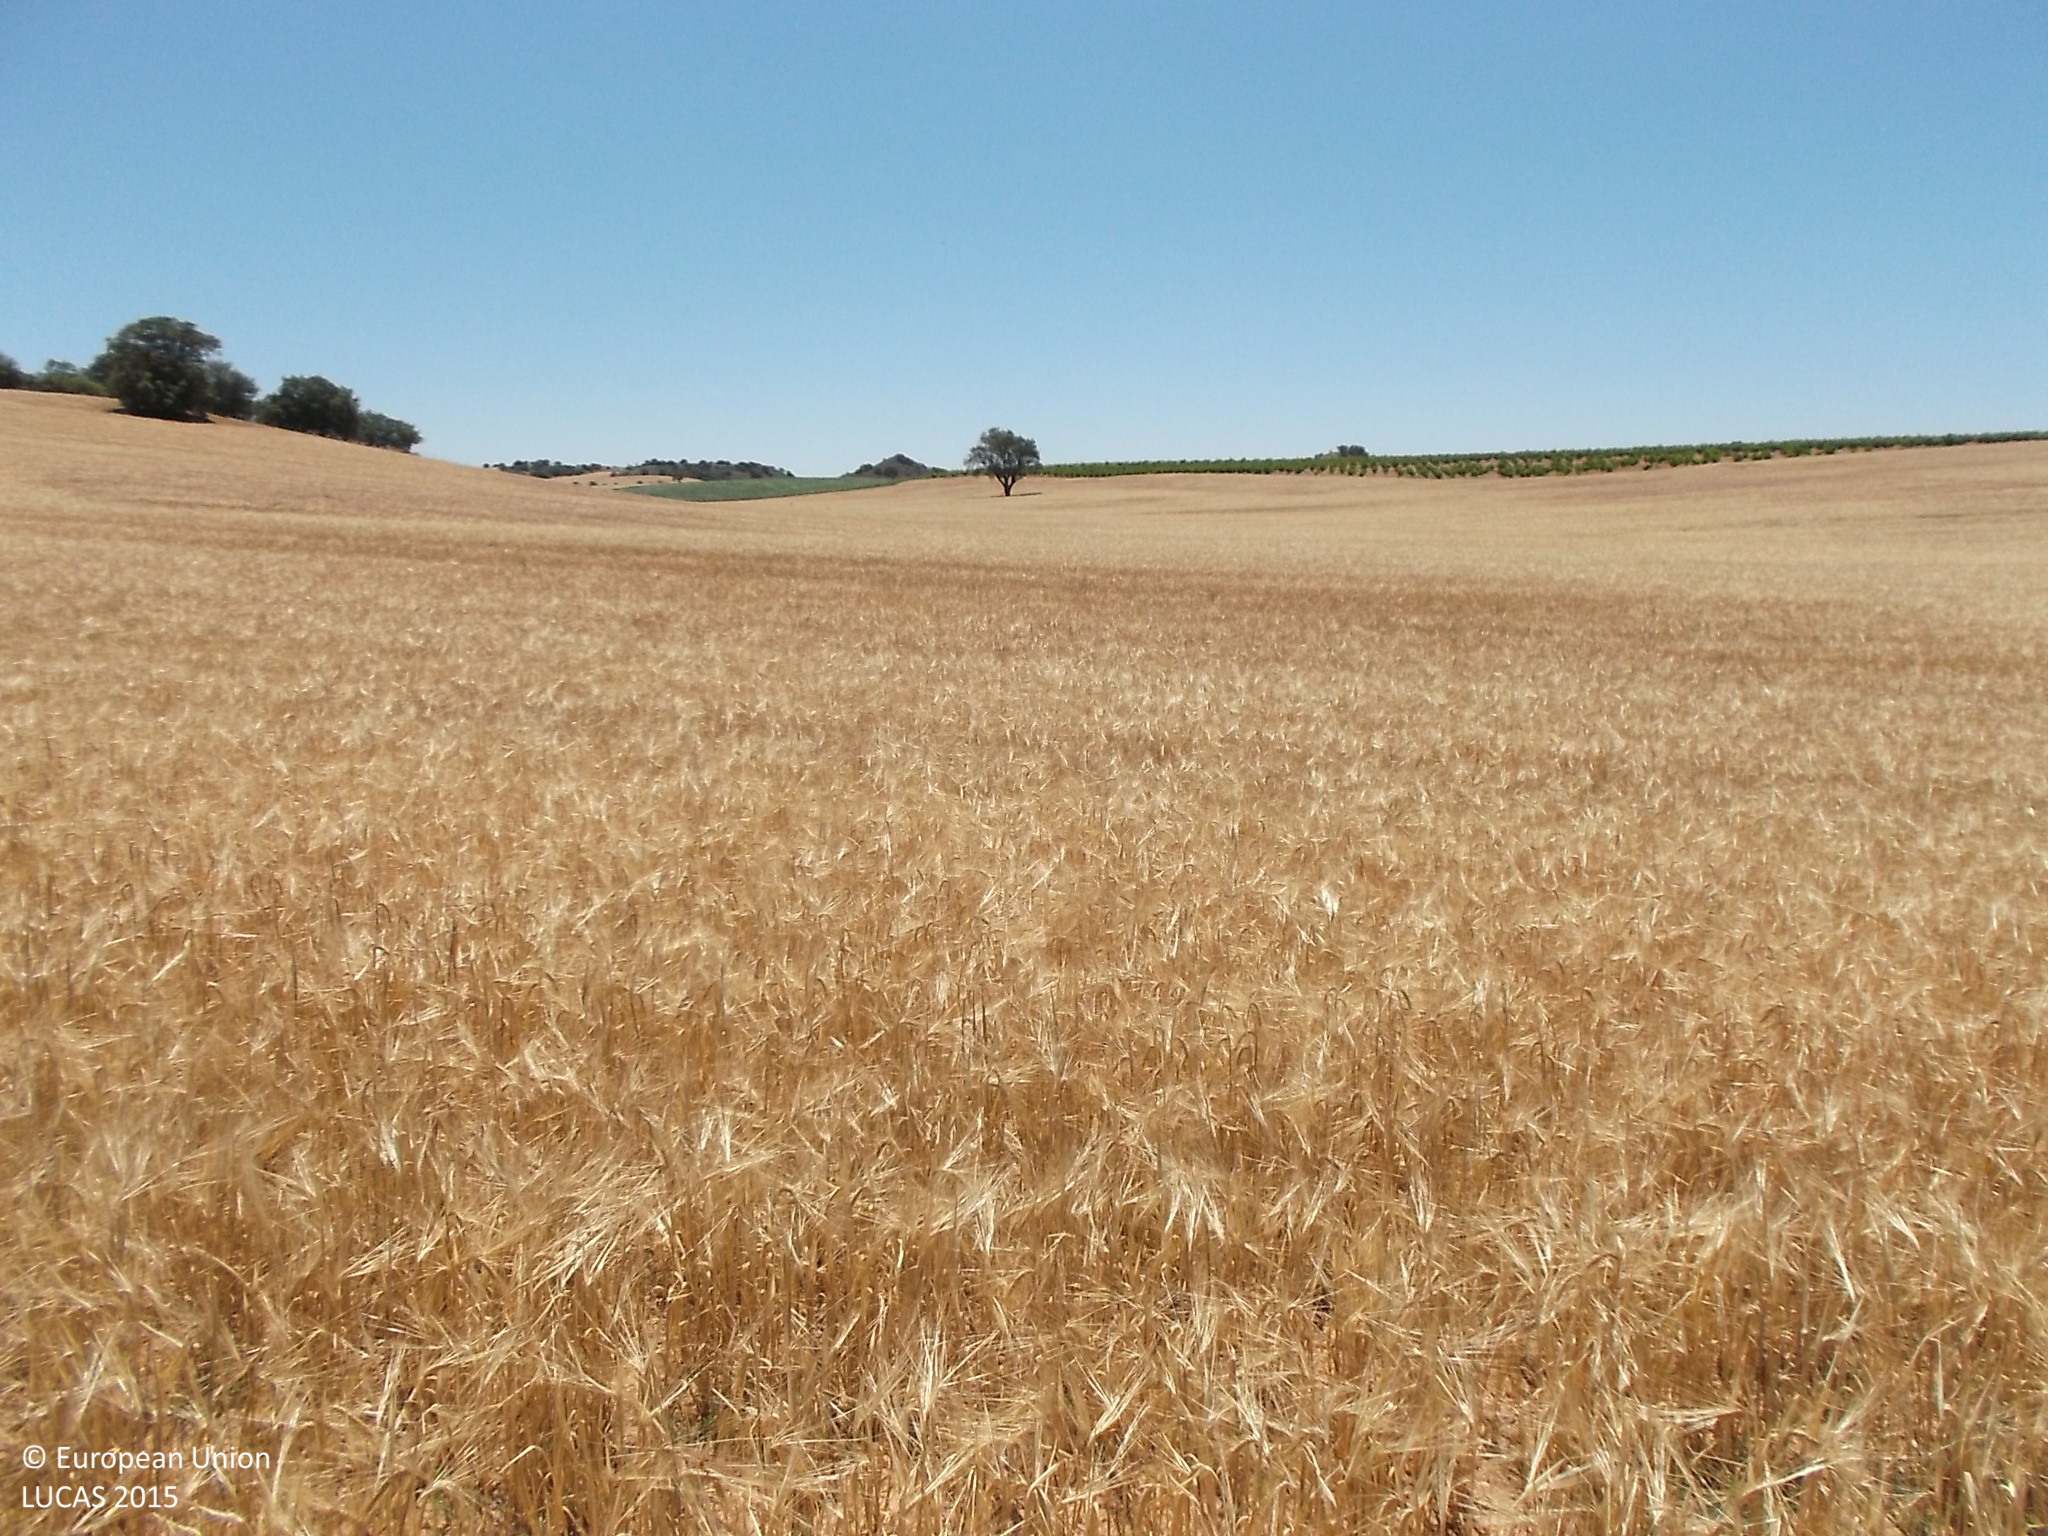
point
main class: Cropland
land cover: Barley
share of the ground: > 75 %
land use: Agriculture (excluding fallow land and kitchen gardens)
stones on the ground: < 10 %
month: June
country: ES
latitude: 41.4021
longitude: -5.3521
